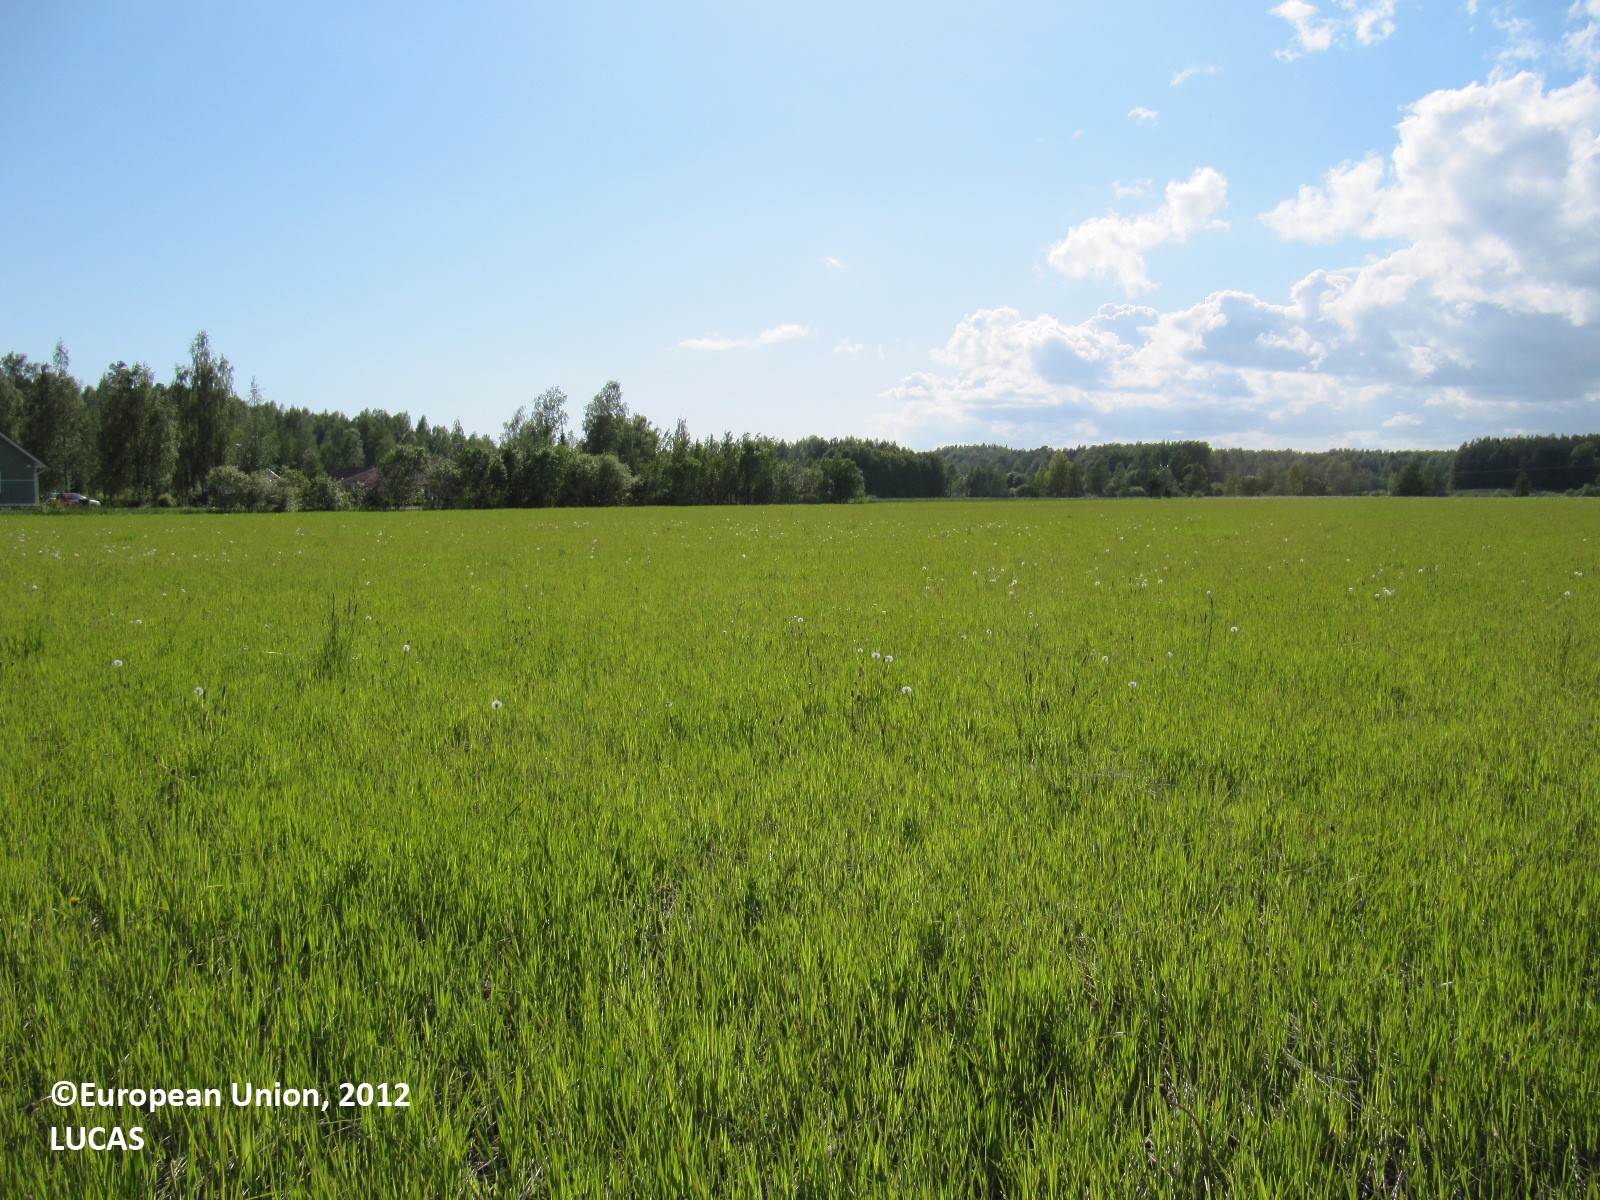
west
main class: Grassland
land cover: Spontaneously vegetated surfaces
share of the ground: > 75 %
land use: Agriculture (excluding fallow land and kitchen gardens)
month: June
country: FI
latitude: 60.1314
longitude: 24.4185
